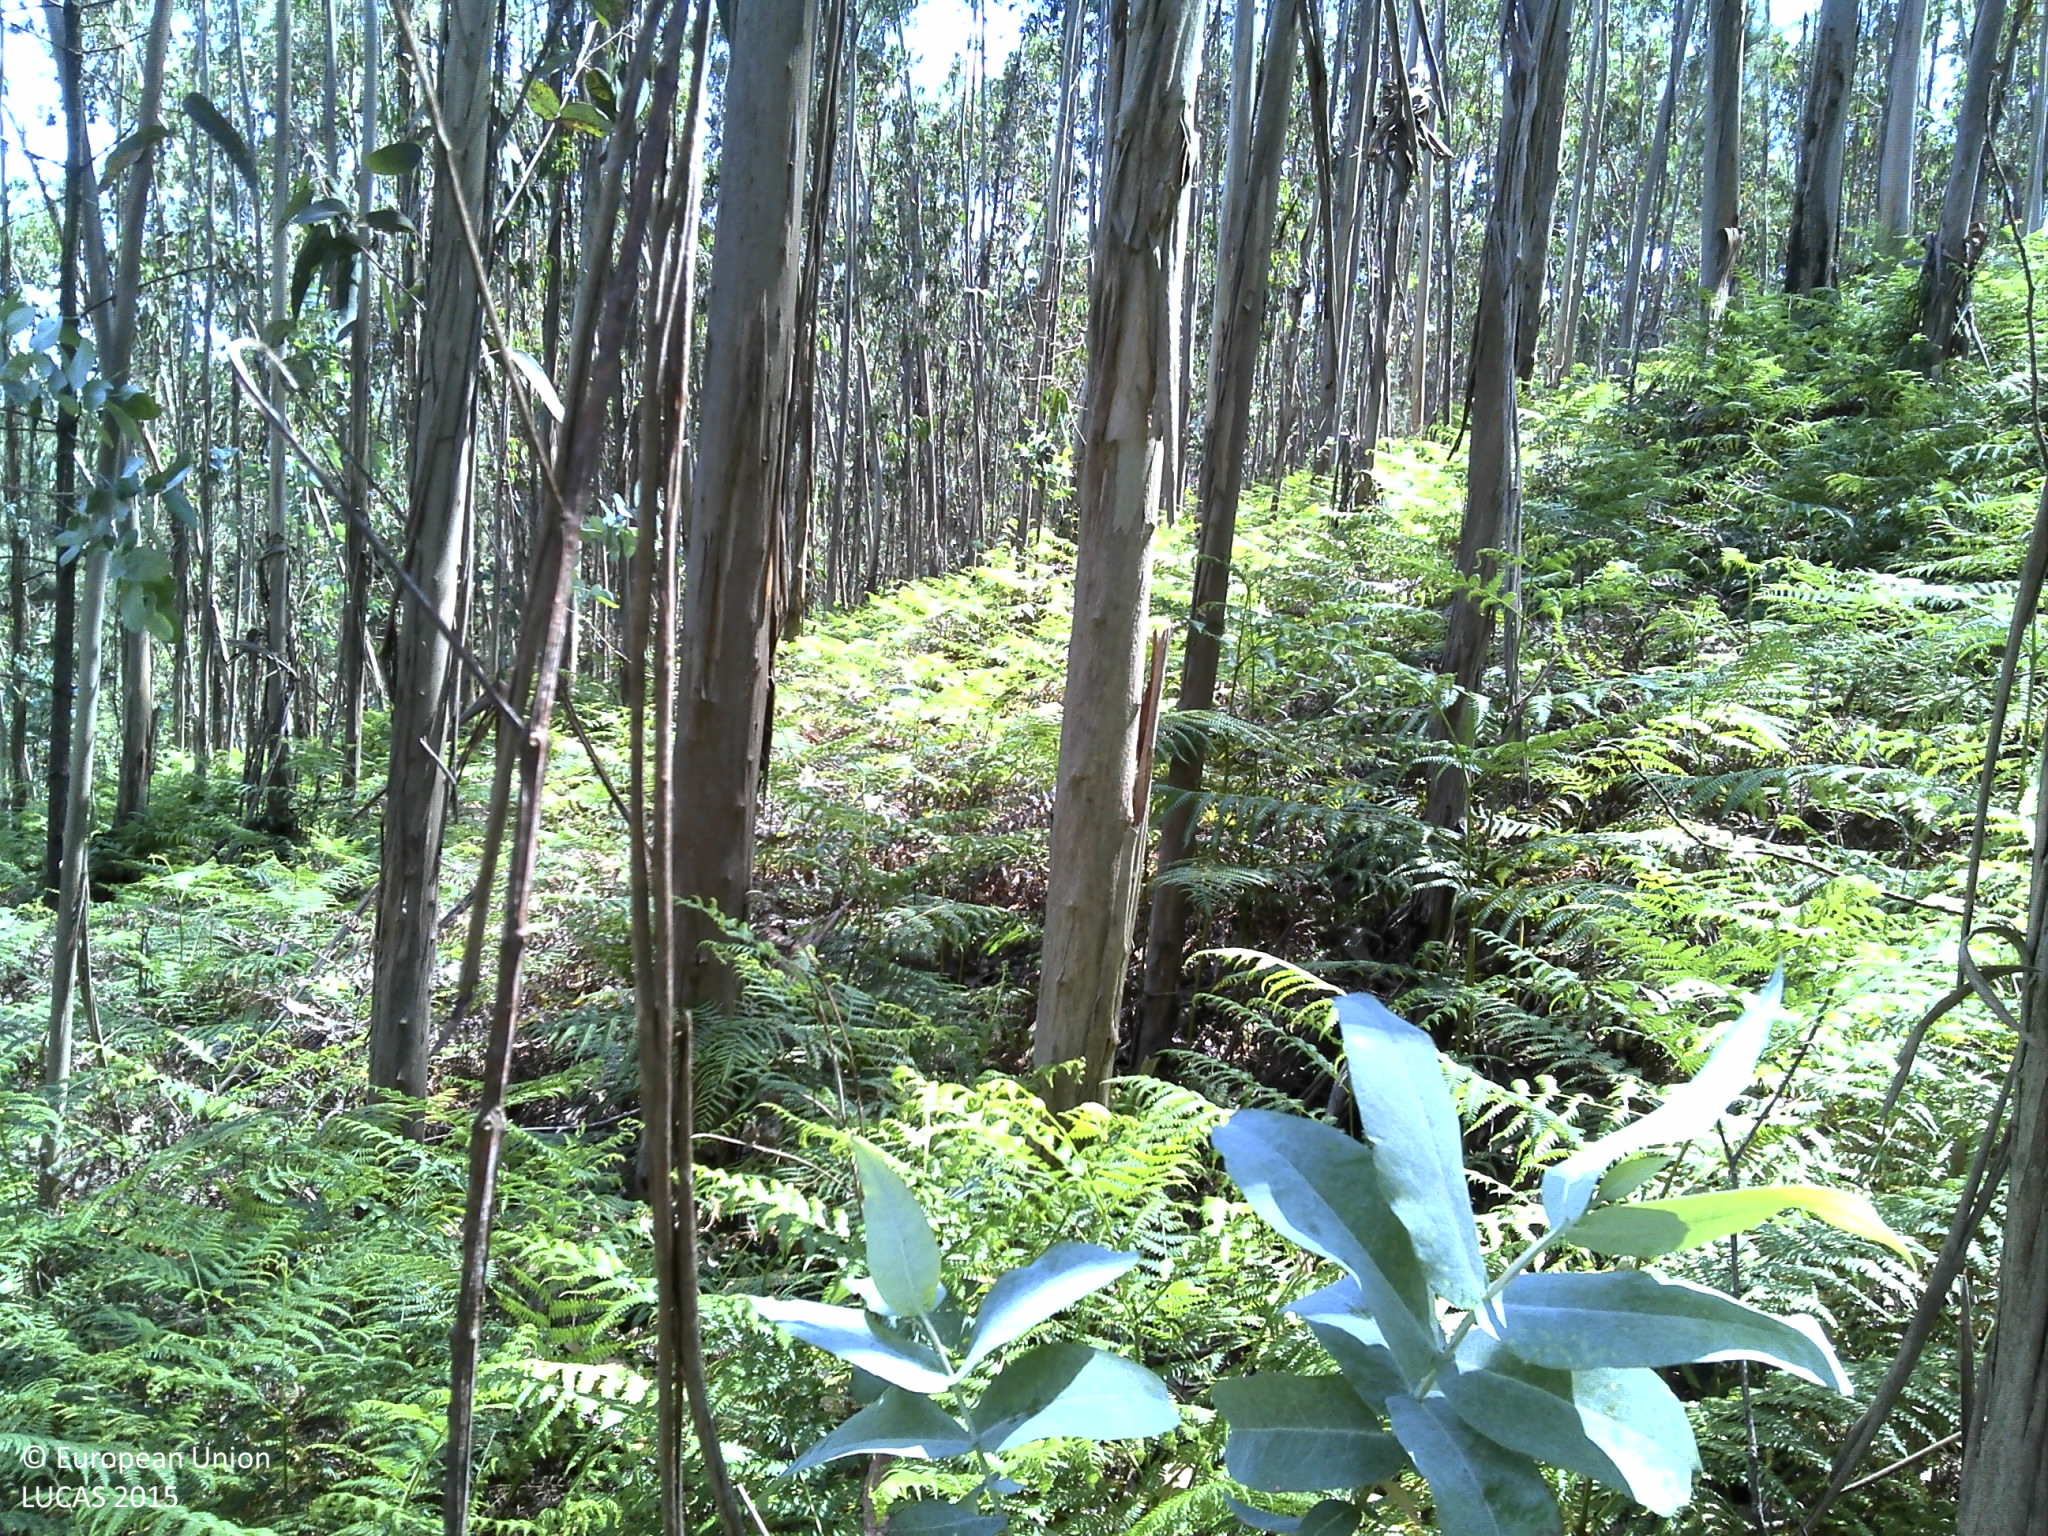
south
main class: Woodland
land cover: Broadleaved woodland
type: exotic forest
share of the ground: 25 - 50 %
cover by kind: broadleaved forest trees 50 %, shrubs 30 %, unconsolidated bare surface 20 %
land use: Forestry
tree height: > 5 m
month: May
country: PT
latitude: 41.3698
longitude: -8.6282
